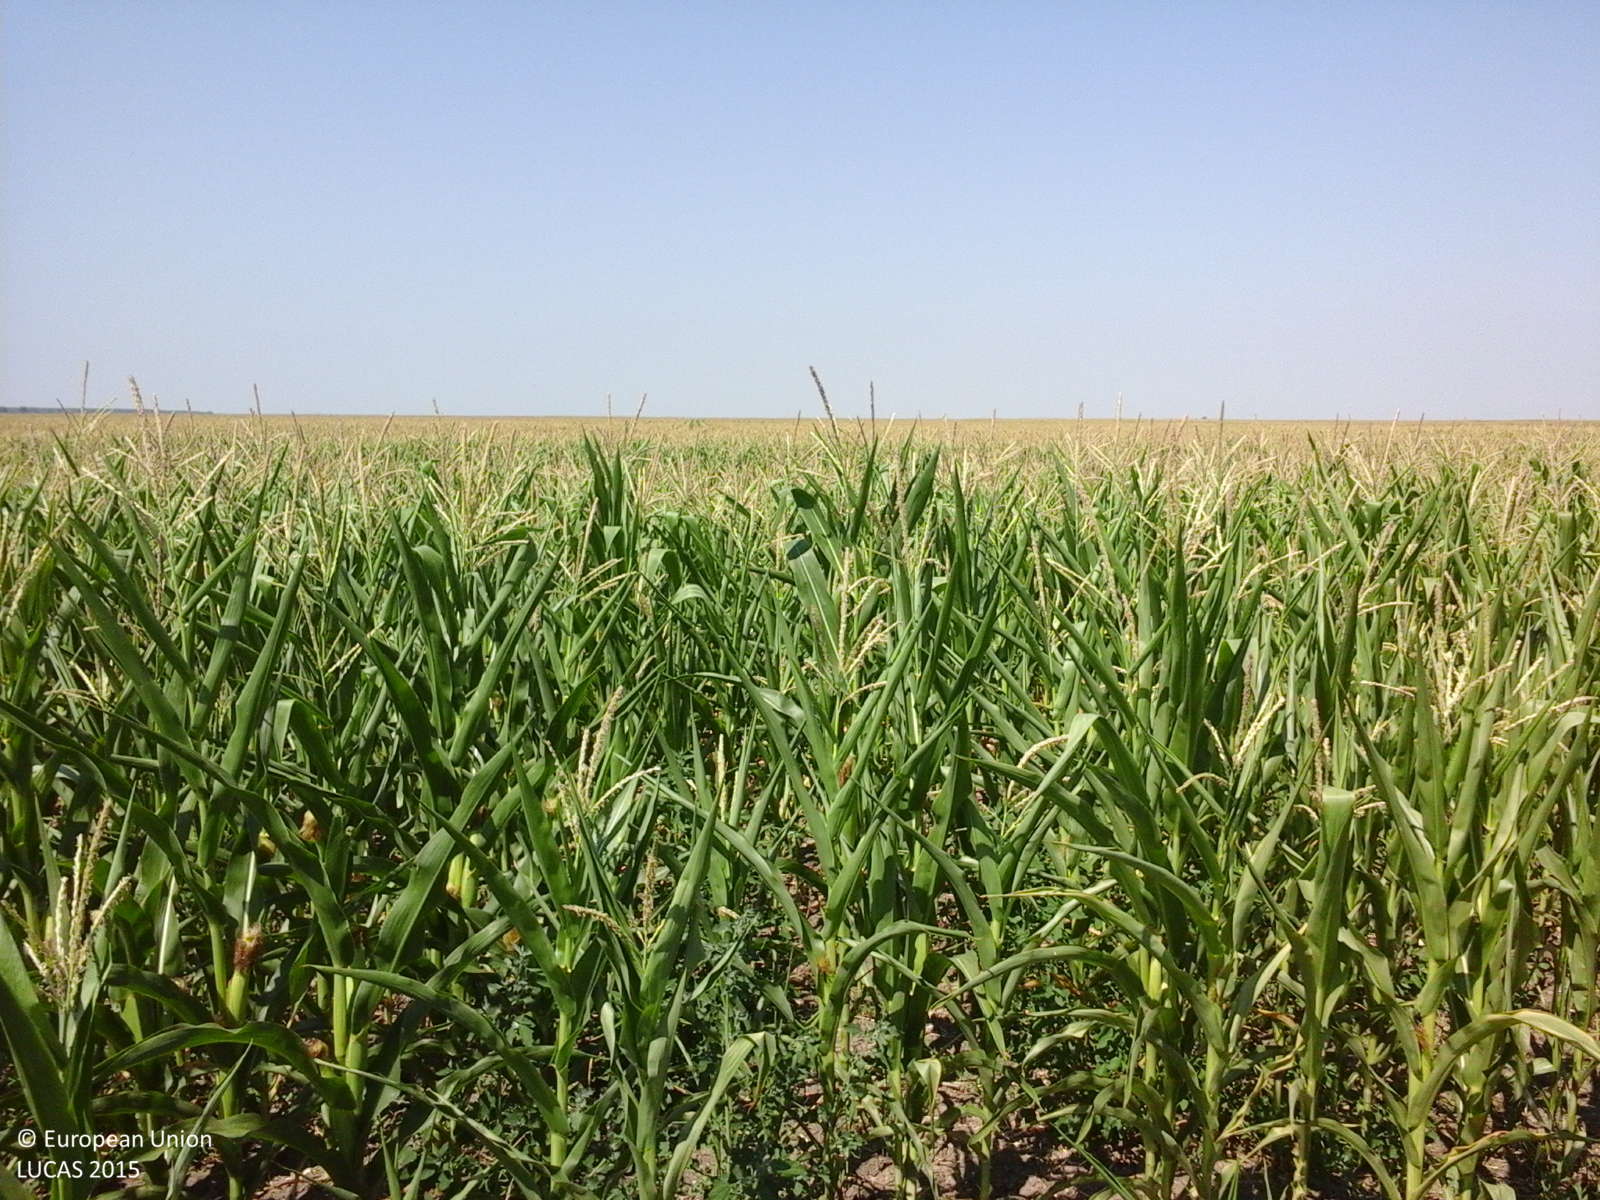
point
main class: Cropland
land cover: Maize
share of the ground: > 75 %
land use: Agriculture (excluding fallow land and kitchen gardens)
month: July
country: RO
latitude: 44.1687
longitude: 26.9962
